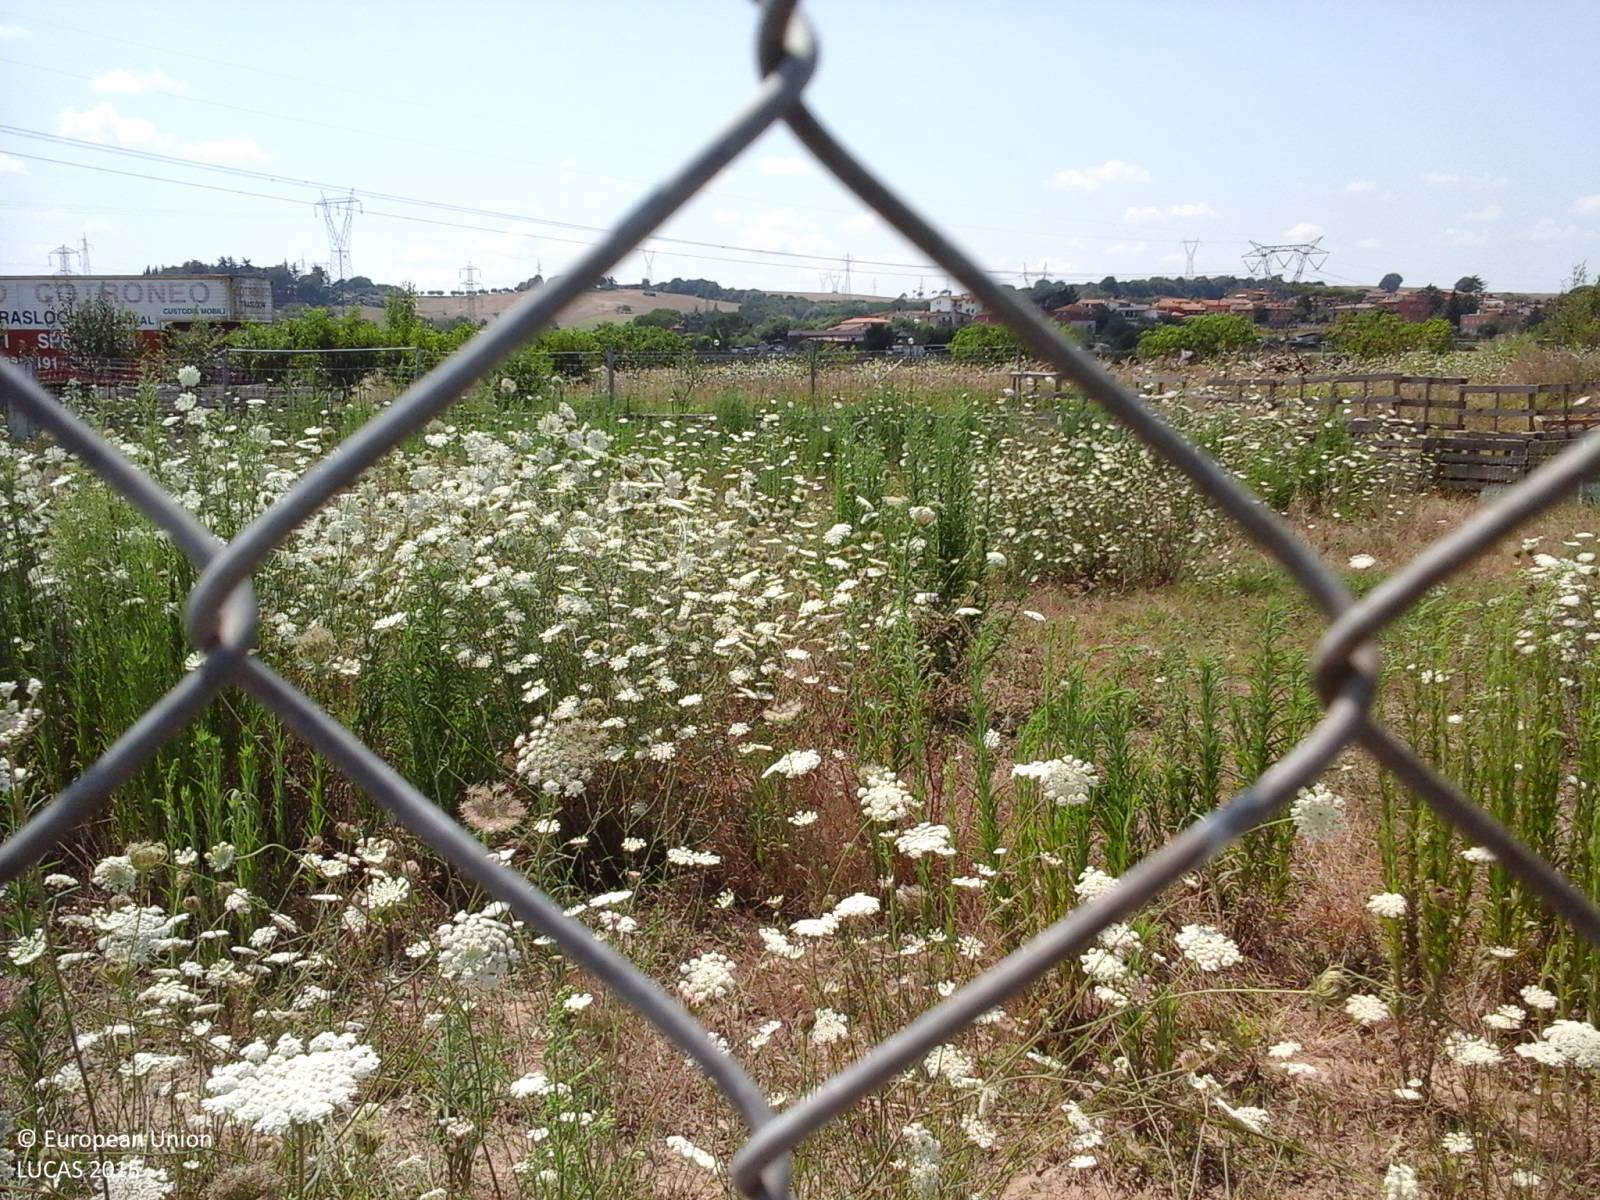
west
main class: Grassland
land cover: Spontaneously vegetated surfaces
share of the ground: 25 - 50 %
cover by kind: herbaceous plants 90 %, unconsolidated bare surface 10 %
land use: Fallow land
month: July
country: IT
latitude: 42.0264
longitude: 12.5151
